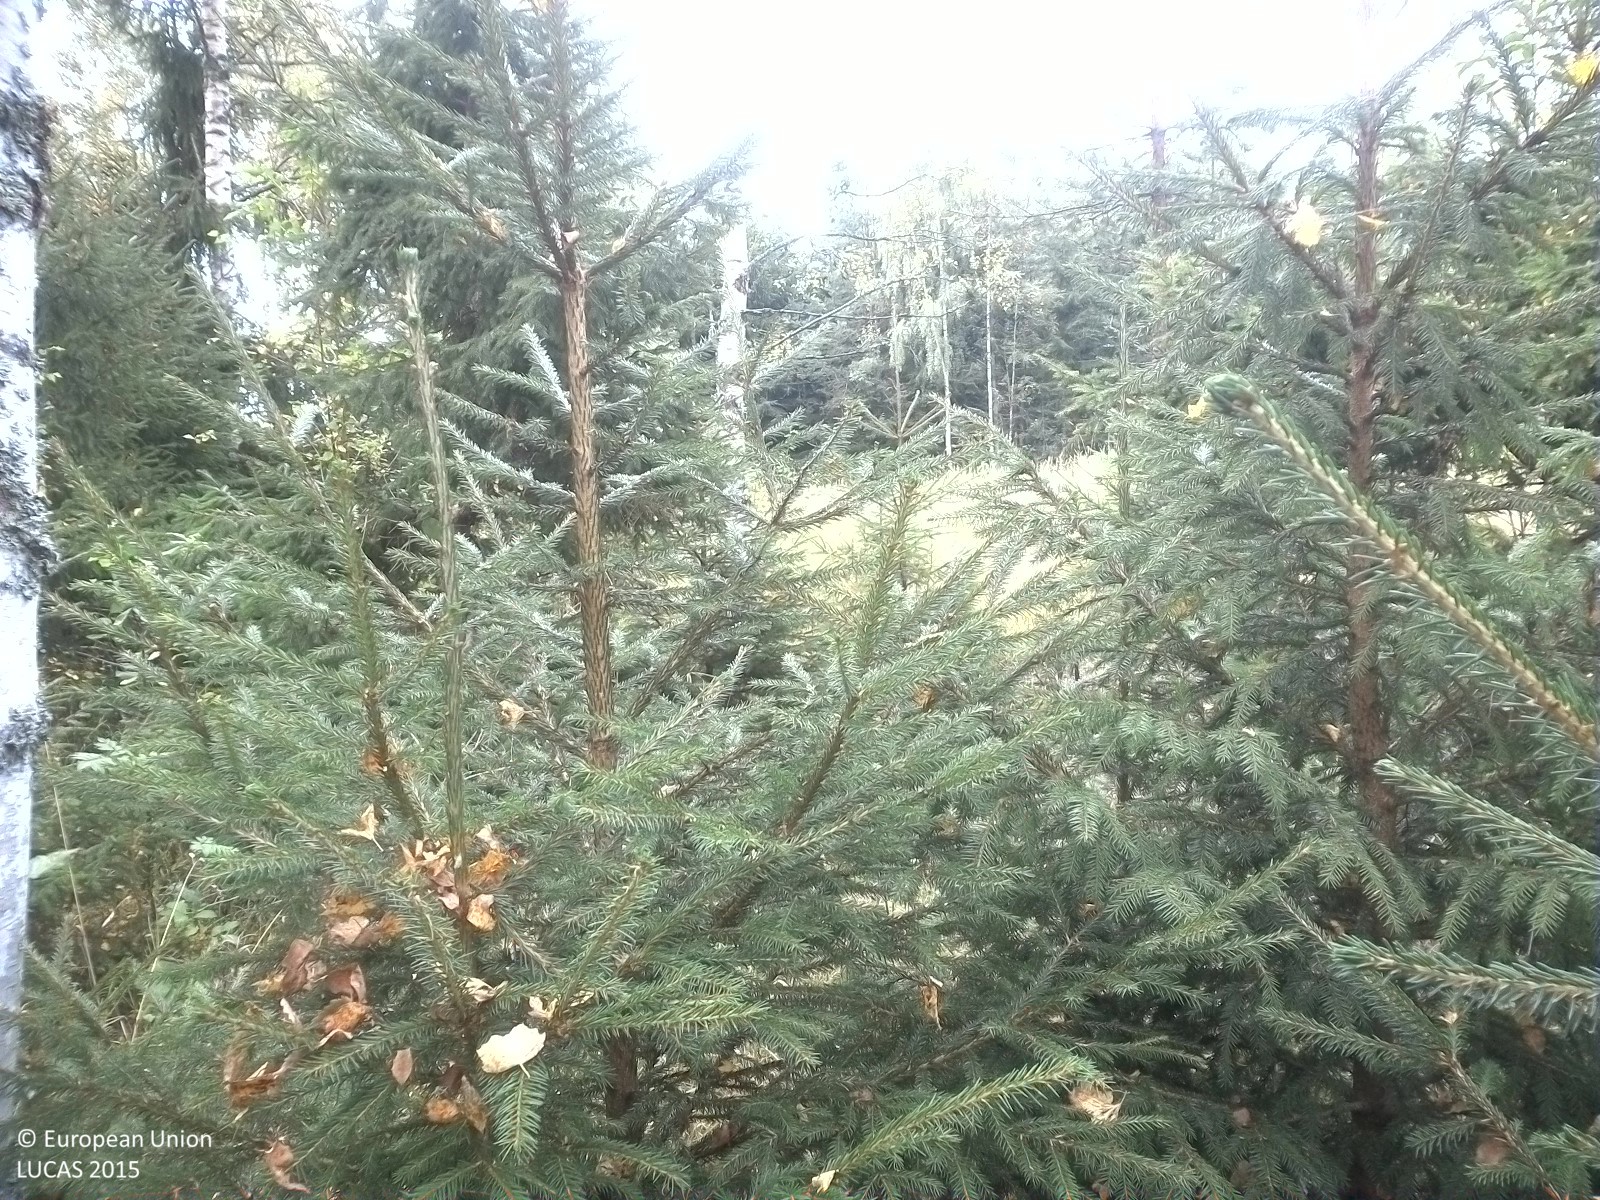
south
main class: Woodland
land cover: Spruce dominated mixed woodland
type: boreal forest
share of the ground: 50 - 75 %
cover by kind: herbaceous plants 35 %, coniferous forest trees 30 %, broadleaved forest trees 30 %, lichens and mosses 5 %
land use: Forestry
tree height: > 5 m
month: August
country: SE
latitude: 58.6849
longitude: 15.0130
